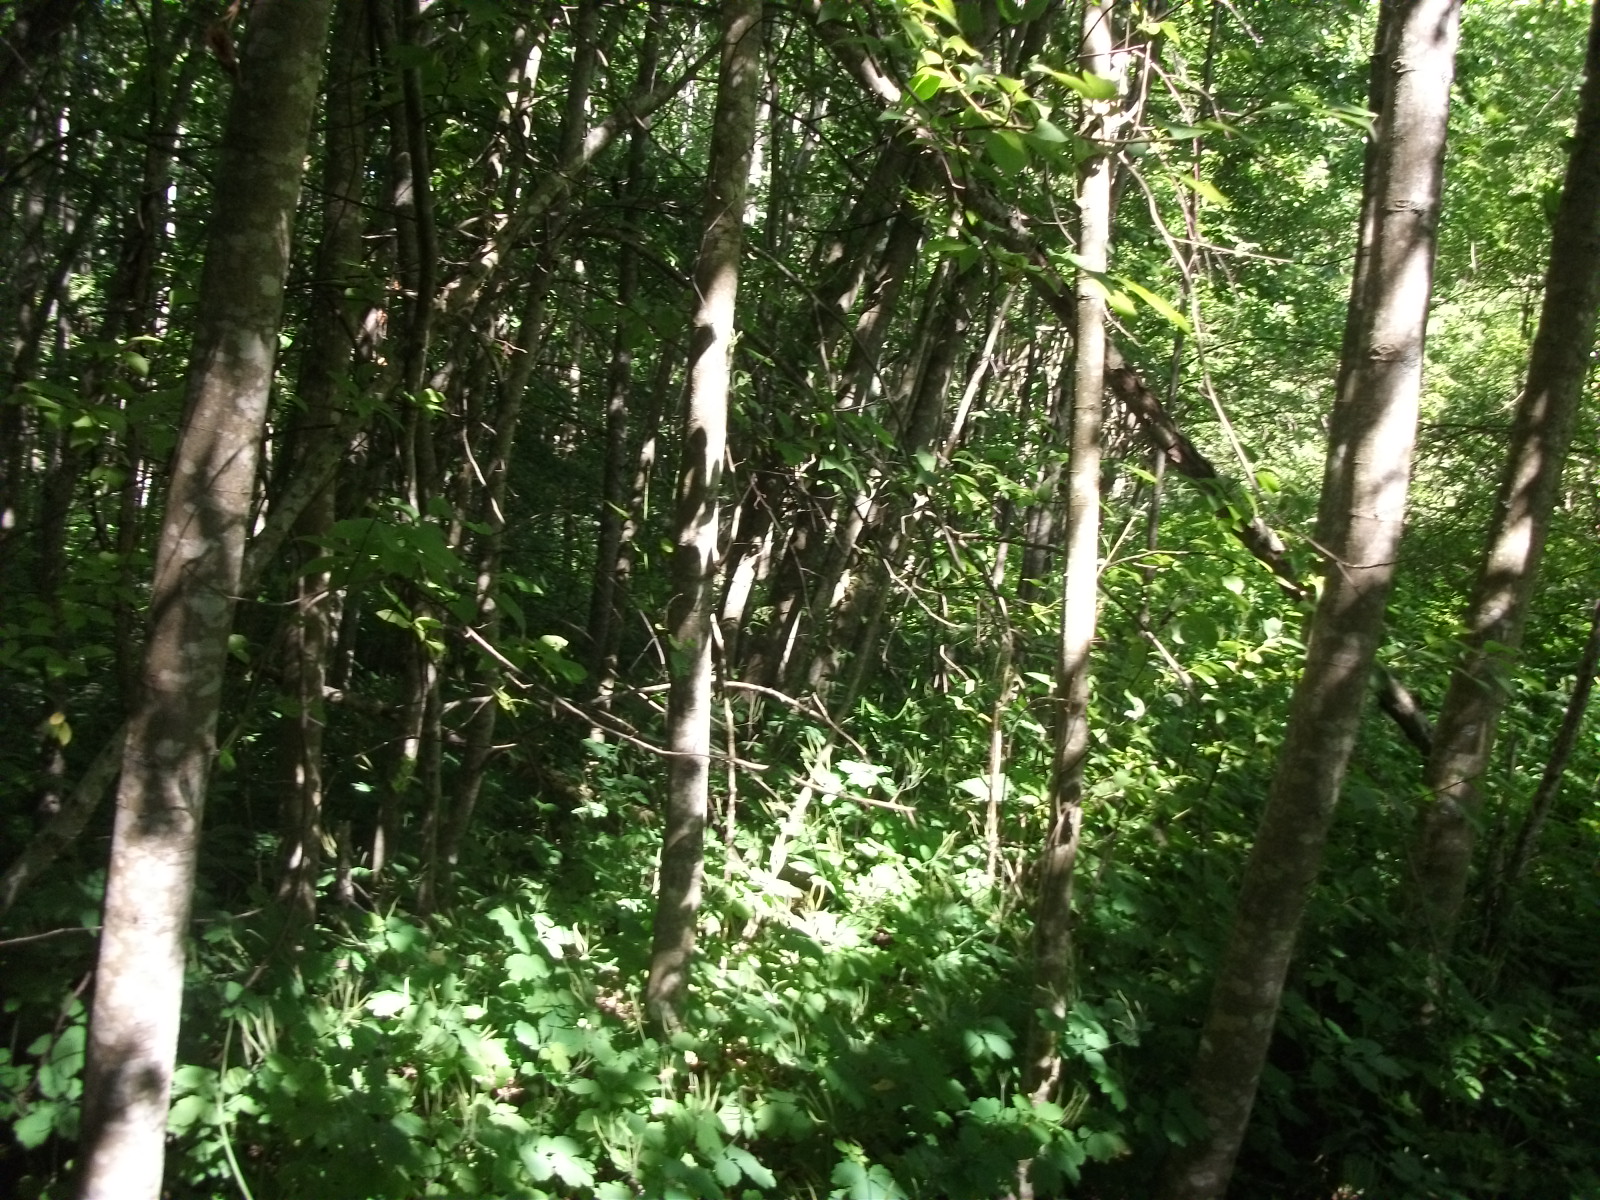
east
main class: Woodland
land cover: Broadleaved woodland
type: non-riverine alder, birch or aspen forest
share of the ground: > 75 %
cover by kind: broadleaved forest trees 100 %
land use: Forestry
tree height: > 5 m
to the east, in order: Broadleaved woodland; Grassland without tree/shrub cover; Other bare soil; Grassland without tree/shrub cover; Single bushes/trees; Grassland without tree/shrub cover
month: July
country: LV
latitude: 56.7330
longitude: 26.1725
